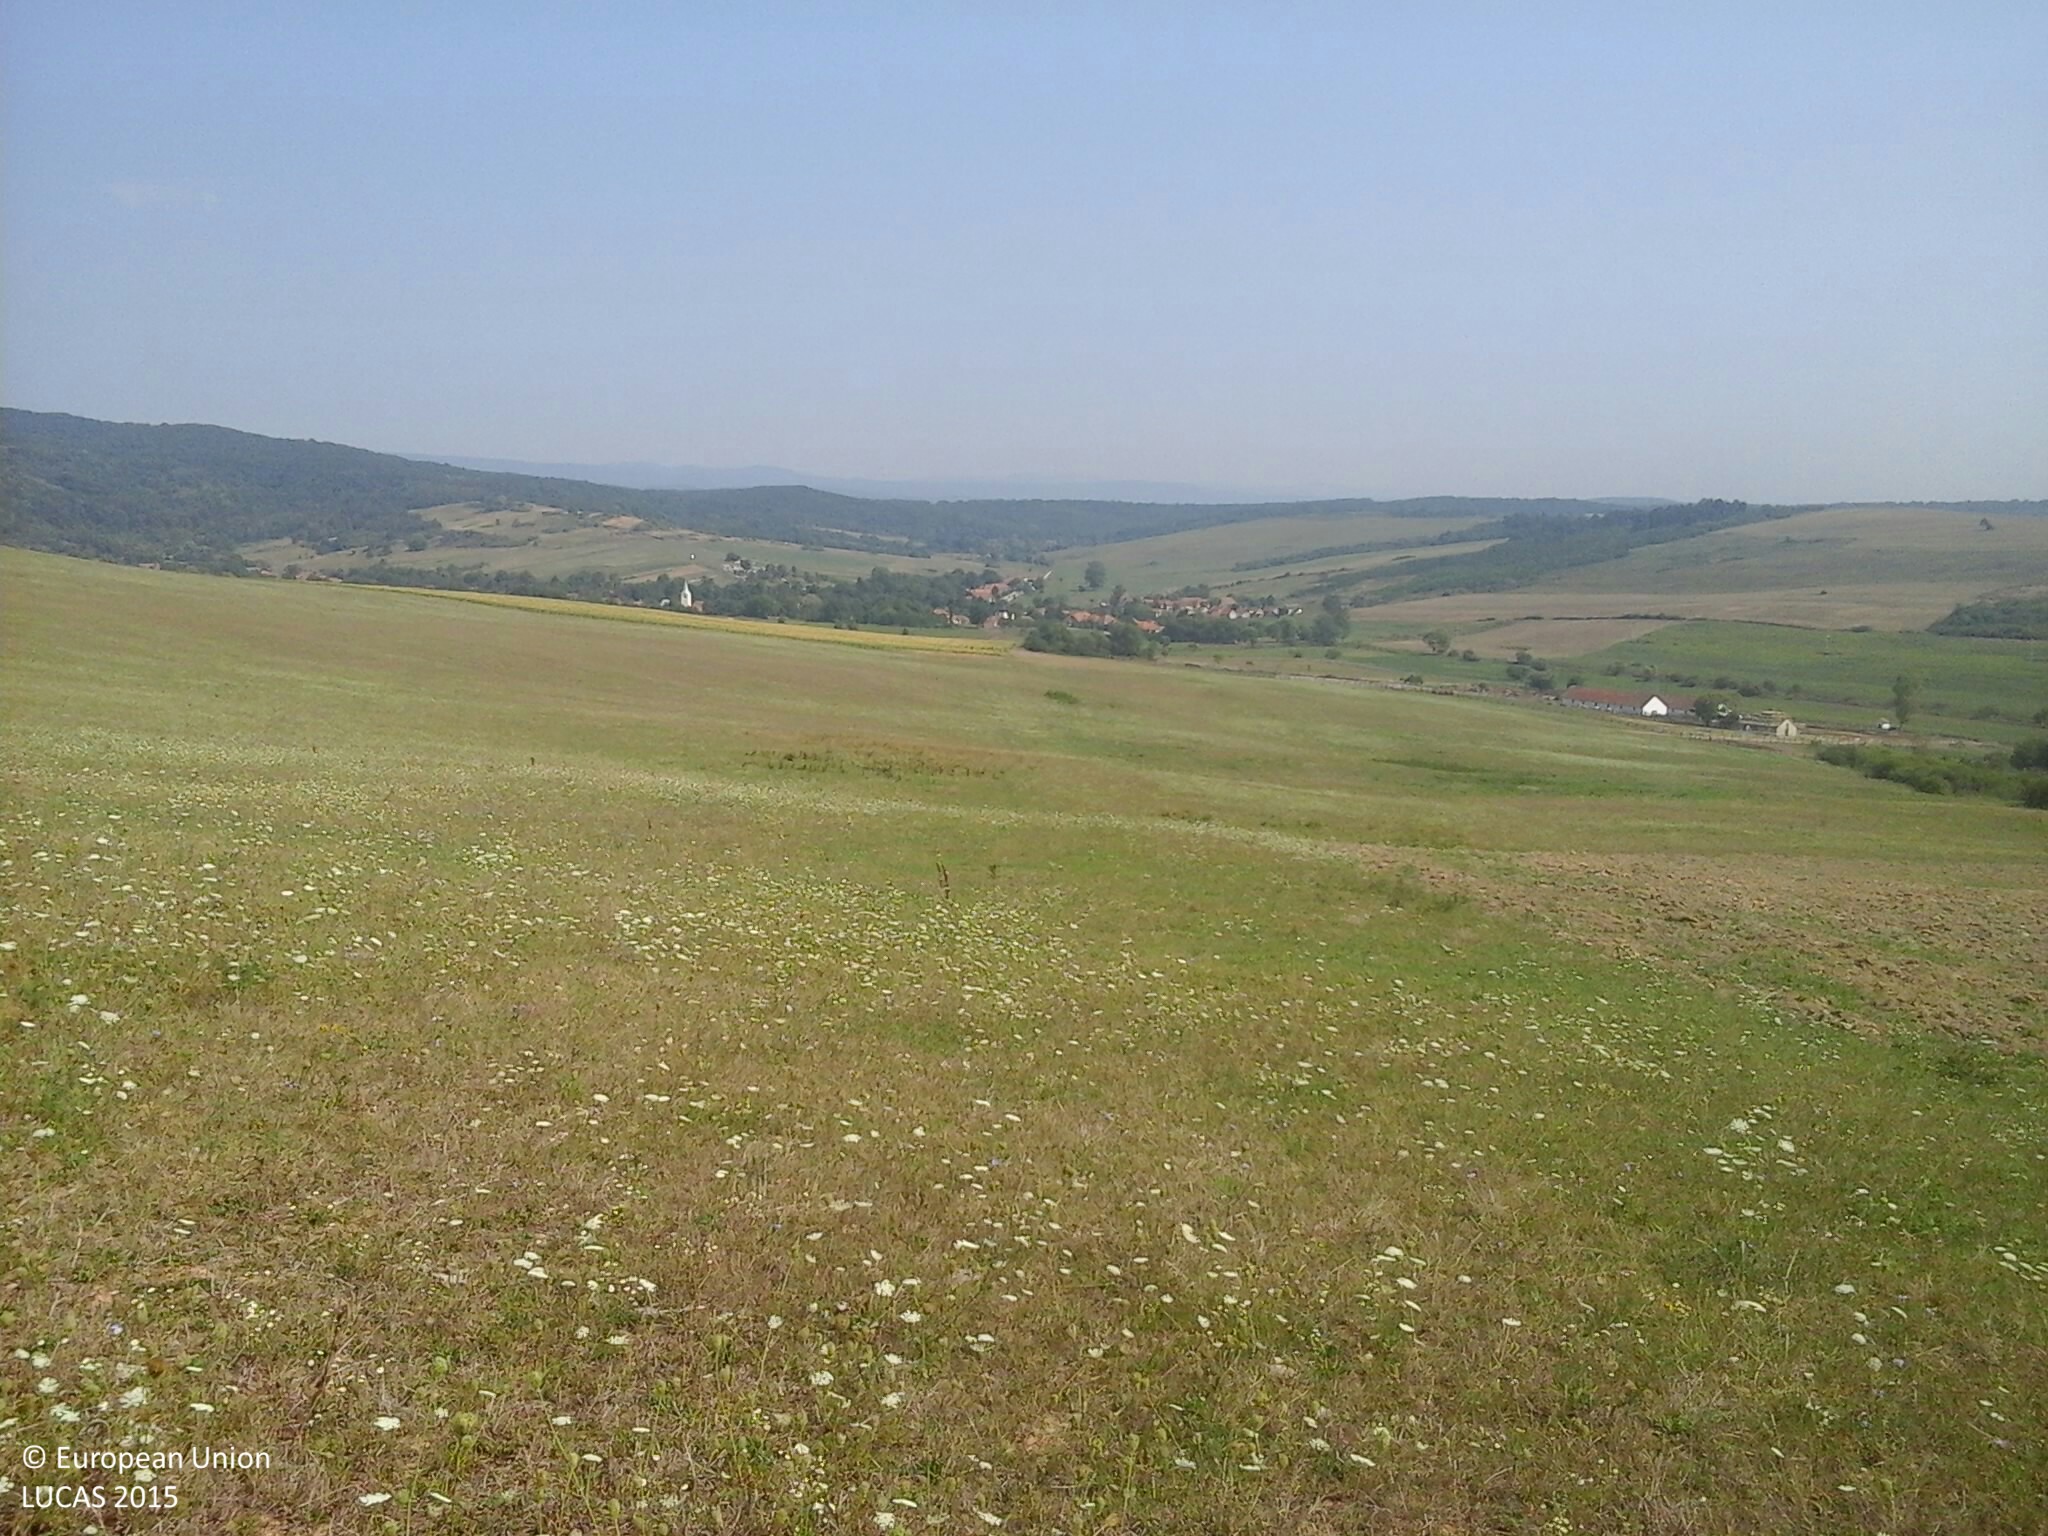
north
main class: Grassland
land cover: Grassland without tree/shrub cover
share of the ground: > 75 %
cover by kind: herbaceous plants 100 %
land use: Agriculture (excluding fallow land and kitchen gardens)
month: August
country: HU
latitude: 48.4575
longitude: 20.7609
